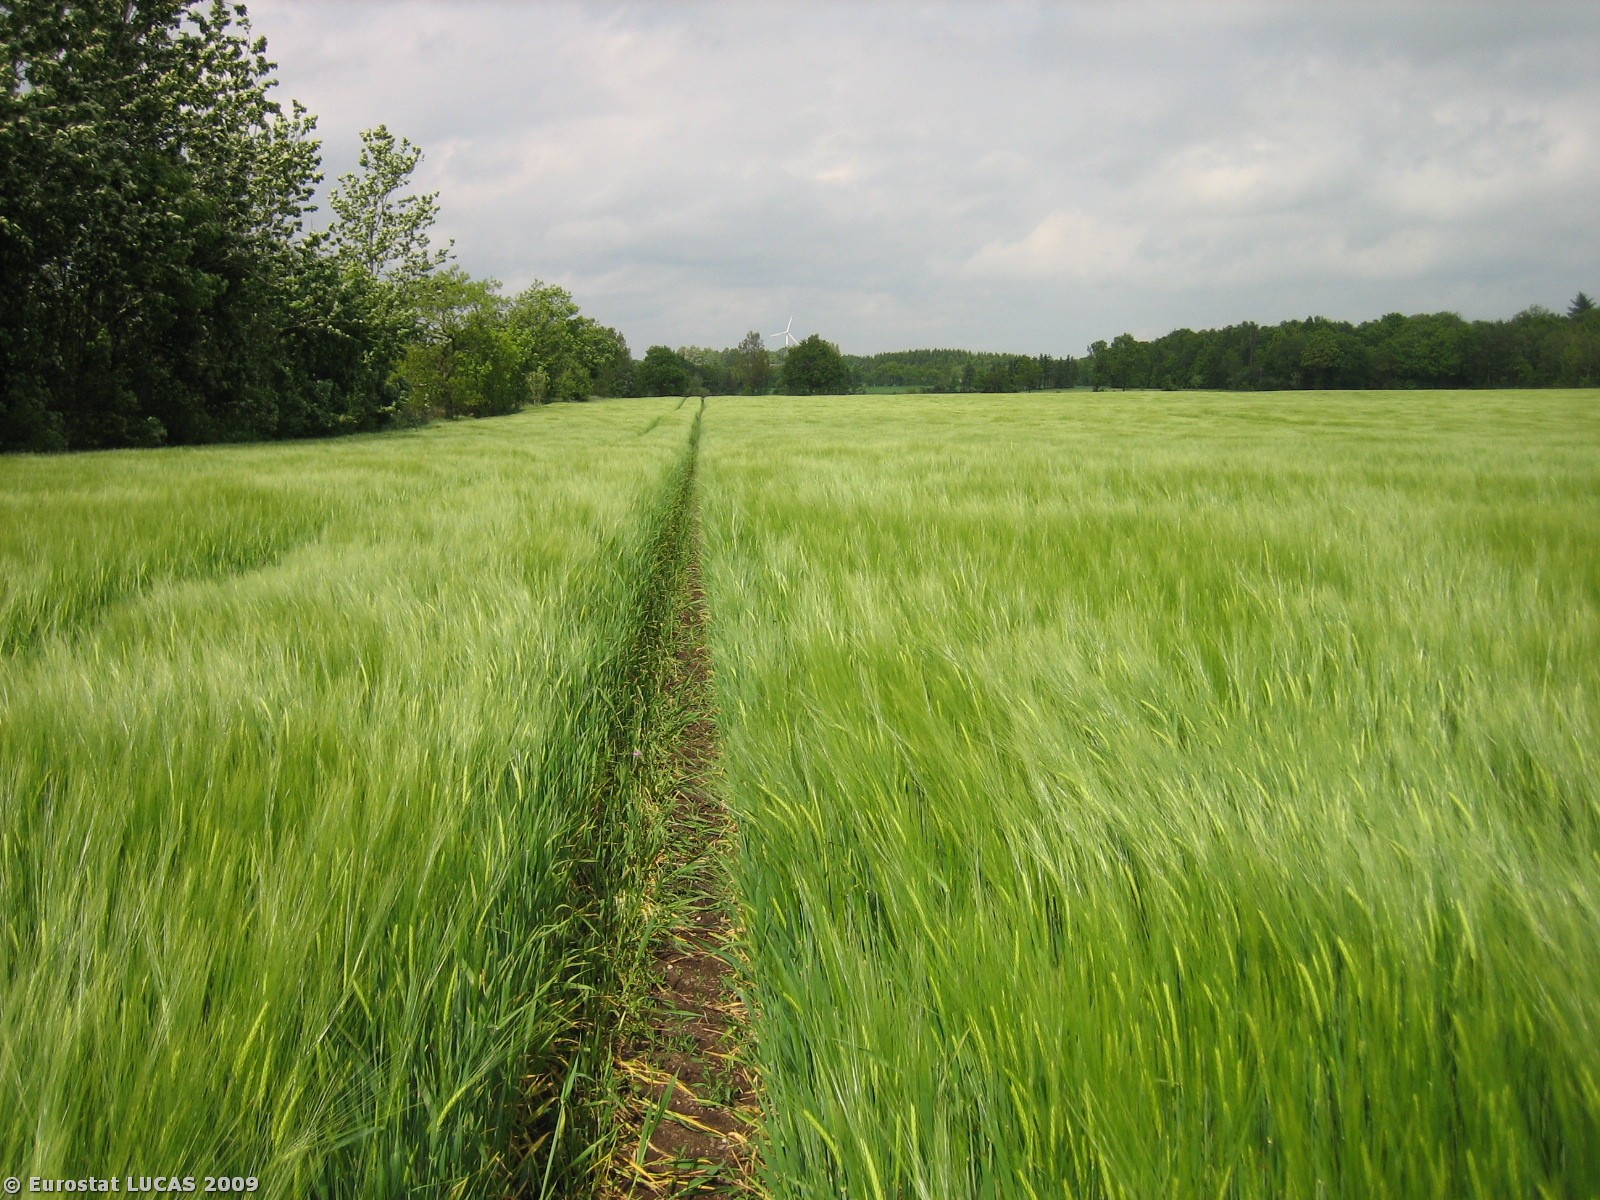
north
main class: Cropland
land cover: Barley
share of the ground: > 75 %
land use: Agriculture (excluding fallow land and kitchen gardens)
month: May
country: DK
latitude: 55.8079
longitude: 9.2190
